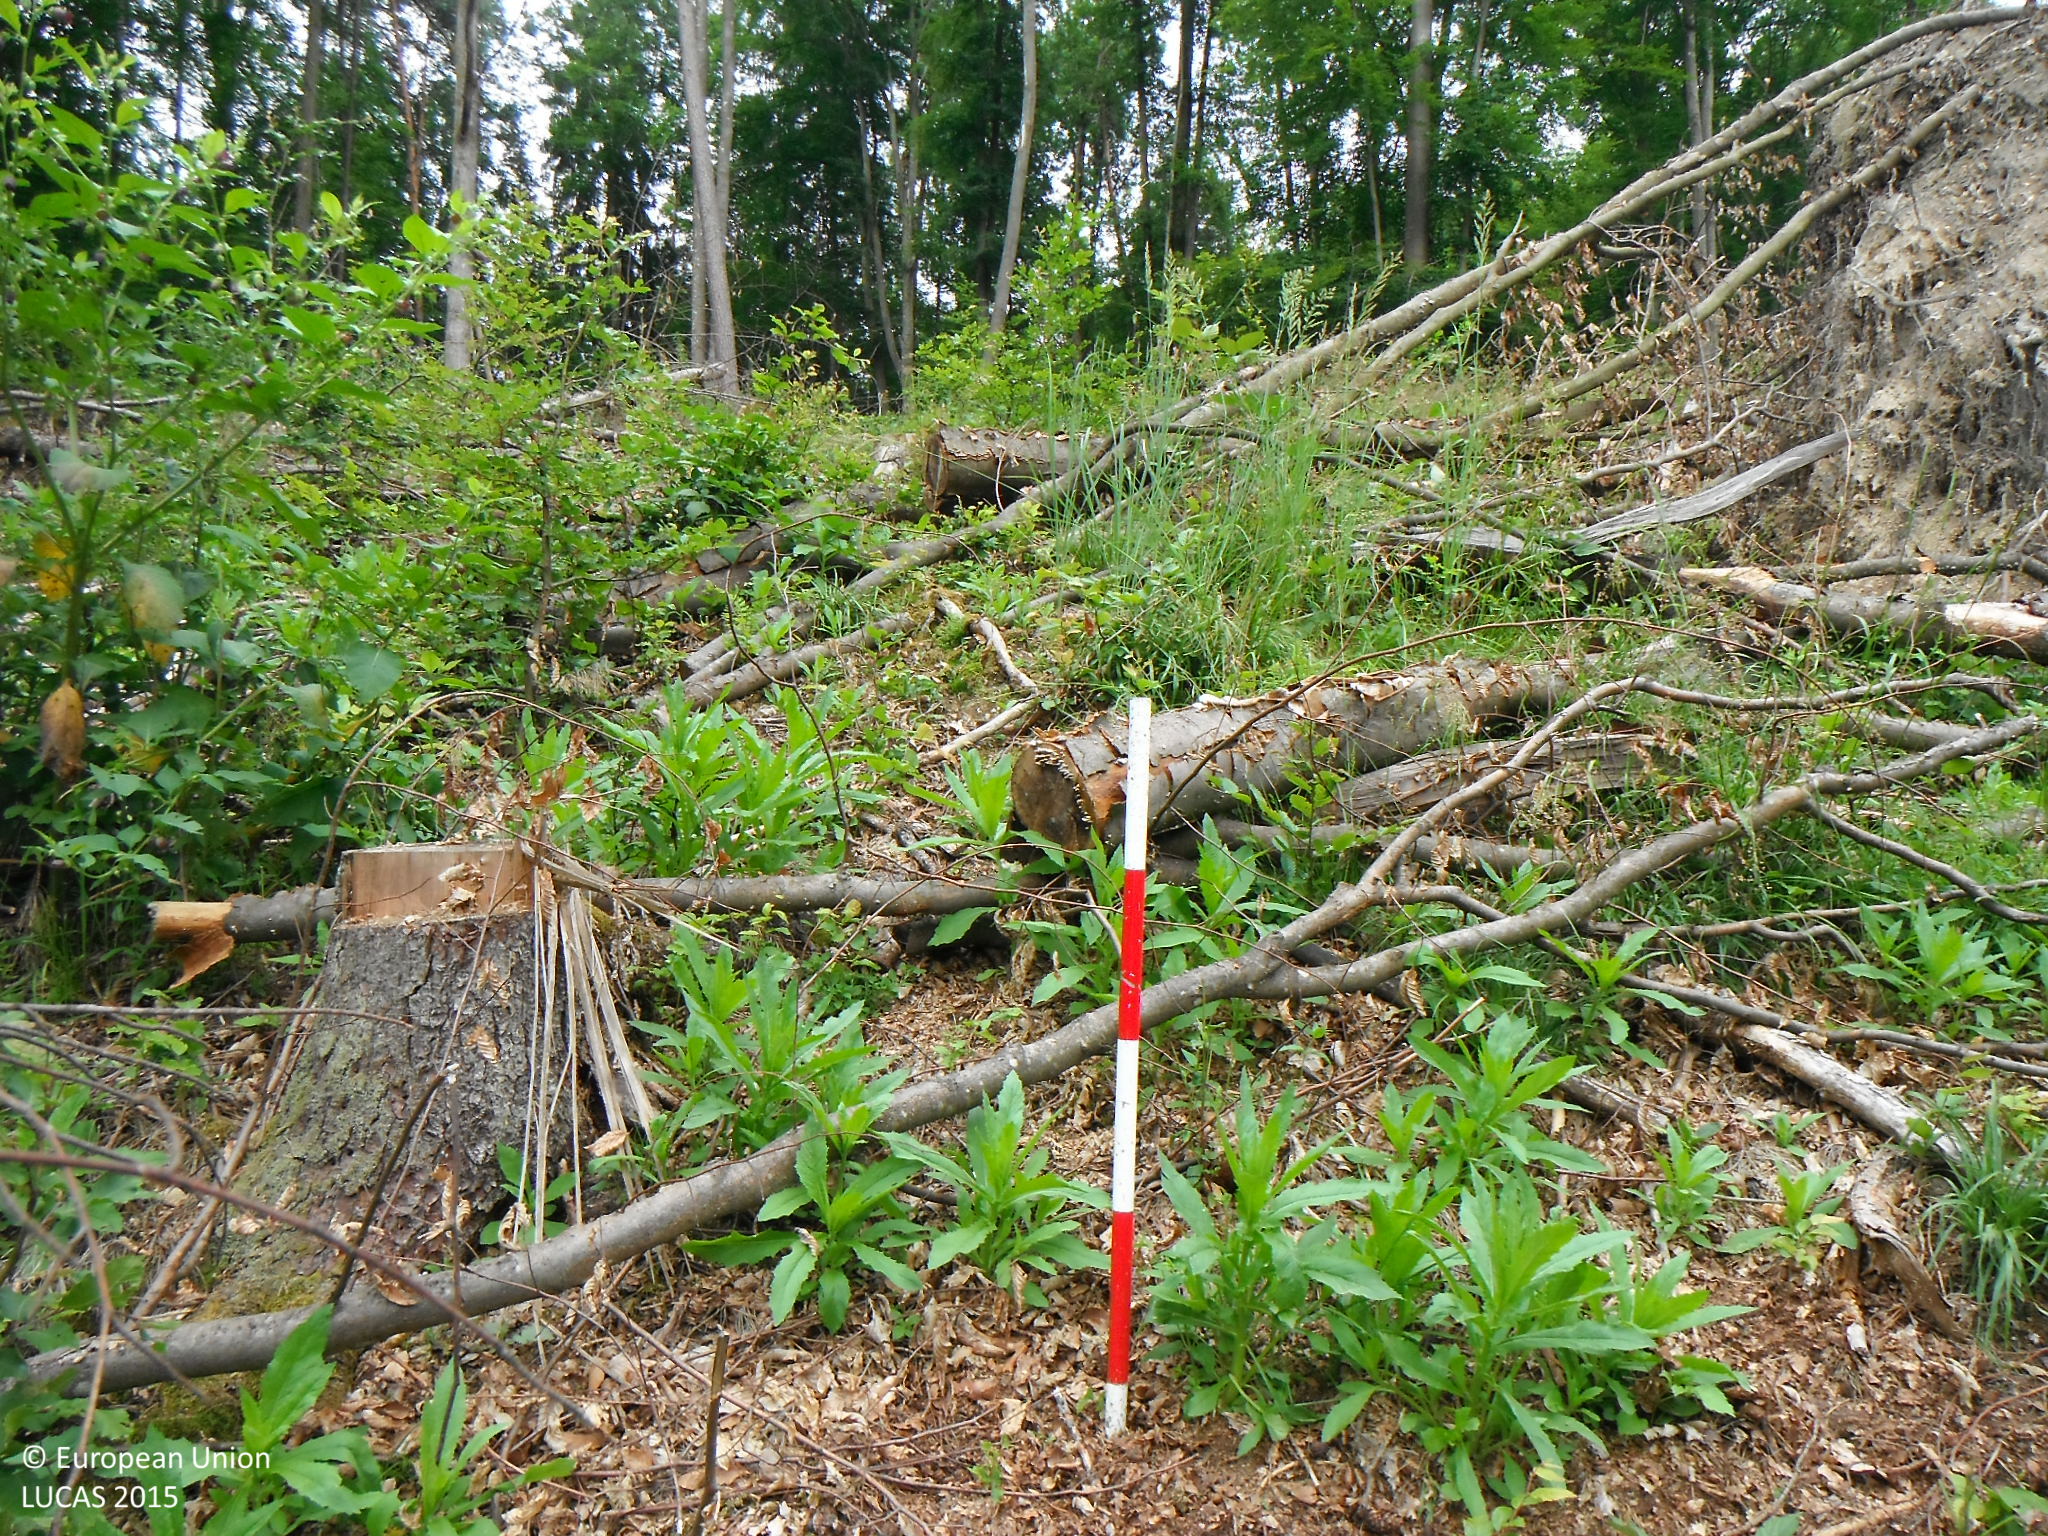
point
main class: Grassland
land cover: Spontaneously vegetated surfaces
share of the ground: 50 - 75 %
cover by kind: herbaceous plants 55 %, unconsolidated bare surface 10 %, shrubs 5 %
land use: Forestry
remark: Clear cut
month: June
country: SK
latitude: 48.5566
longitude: 20.0974
